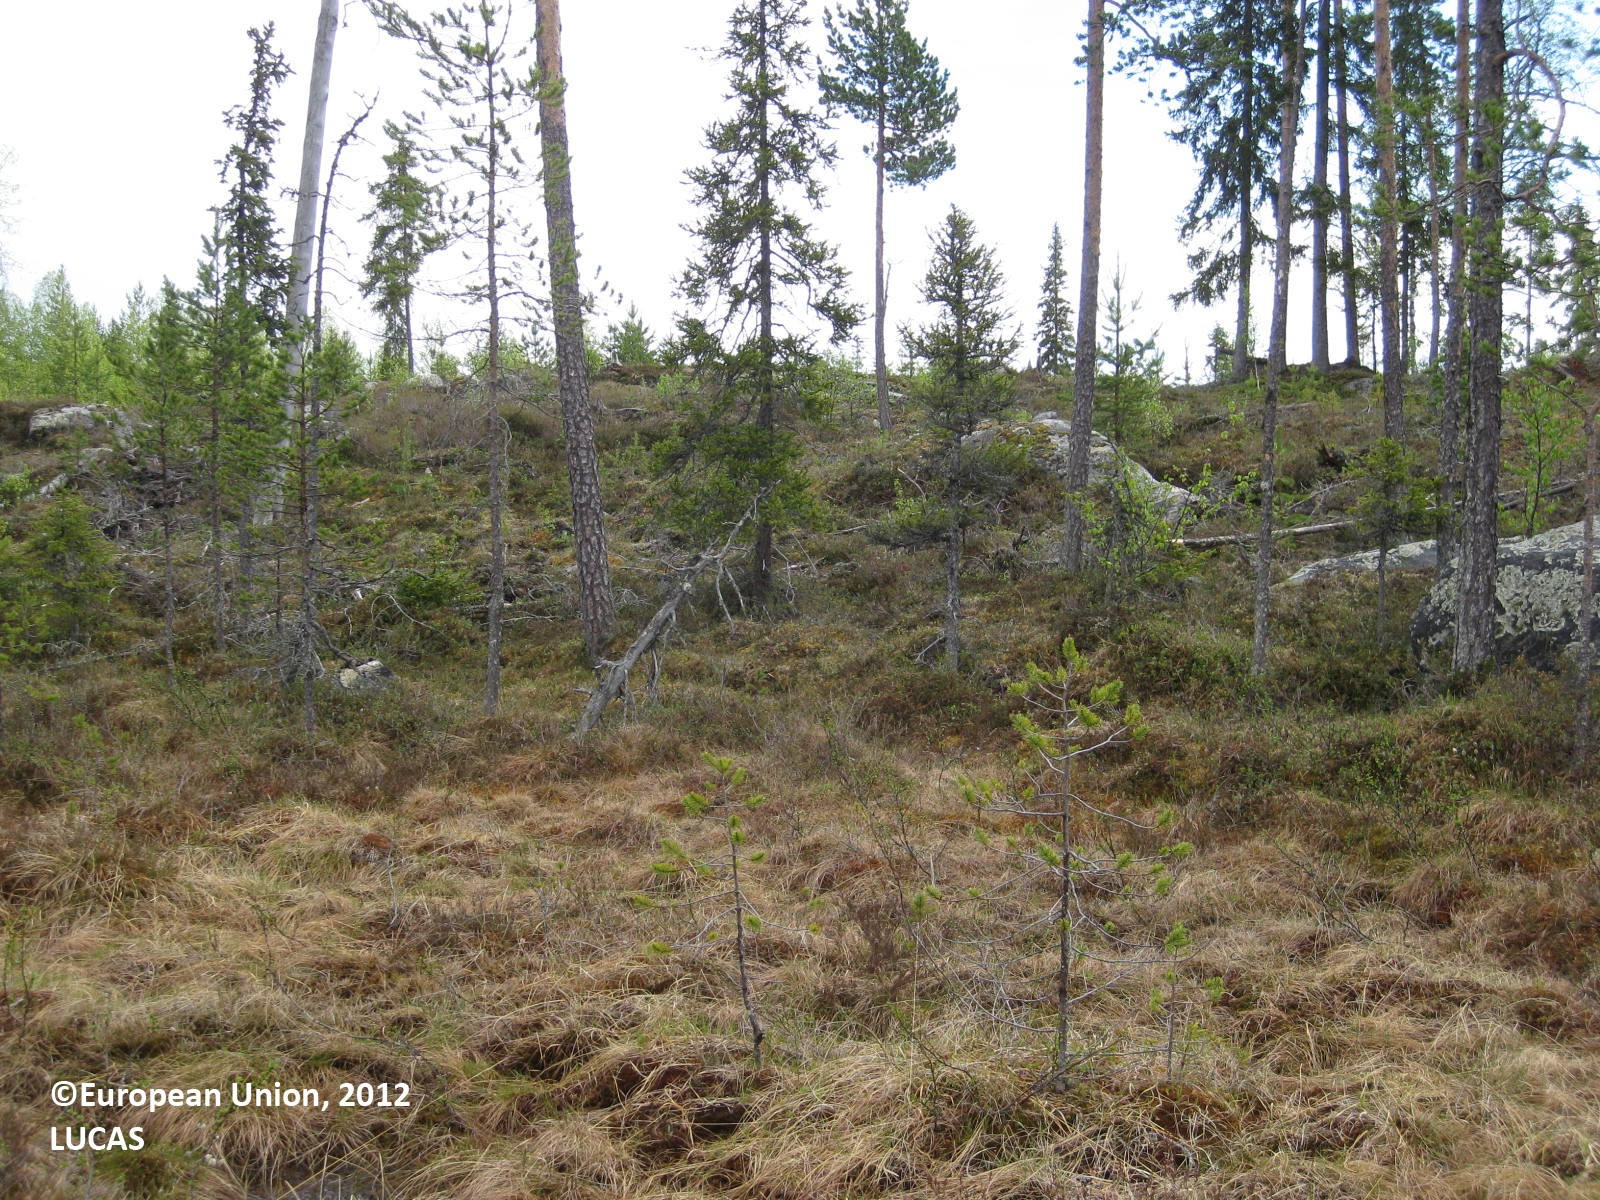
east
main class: Woodland
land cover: Pine dominated mixed woodland
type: boreal forest
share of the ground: 25 - 50 %
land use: Forestry
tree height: > 5 m
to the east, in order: Pine dominated mixed woodland; Grassland with sparse tree/shrub cover; Pine dominated mixed woodland; Shrubland with sparse tree cover; Pine dominated mixed woodland; Shrubland with sparse tree cover; Paved roads, cycling and walking lanes; Shrubland with sparse tree cover; Broadleaved woodland; Ditches and canals; Broadleaved woodland; Pine dominated mixed woodland; Spruce dominated mixed woodland
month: June
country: FI
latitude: 65.2089
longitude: 29.6815
